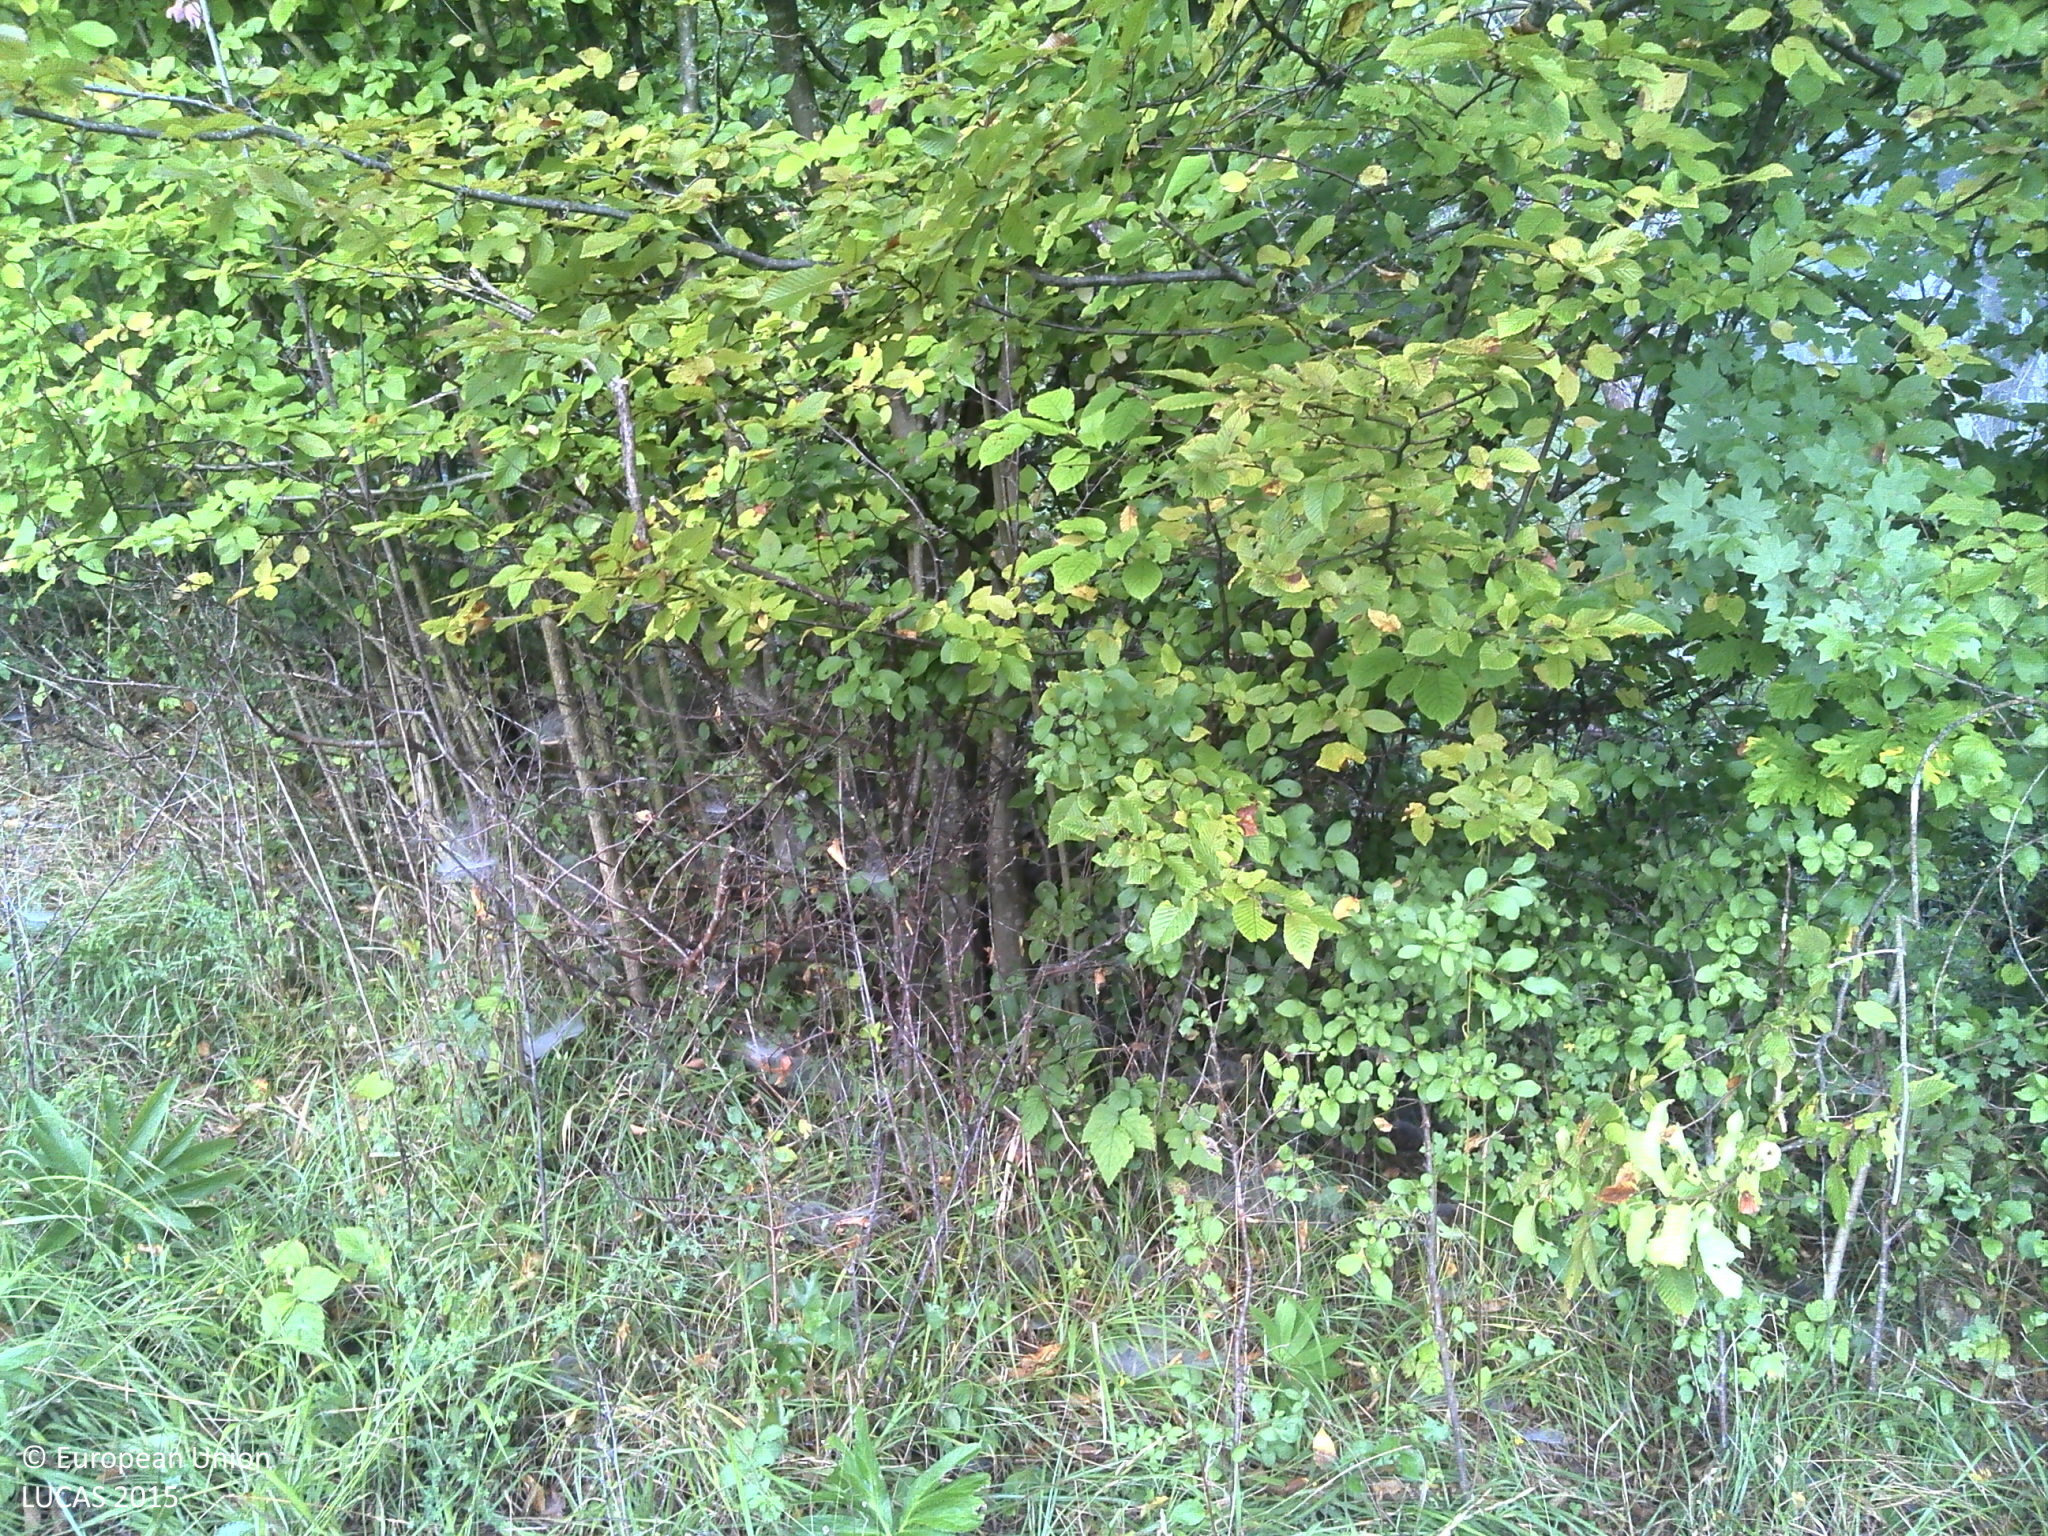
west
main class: Grassland
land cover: Spontaneously vegetated surfaces
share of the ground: > 75 %
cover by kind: herbaceous plants 95 %, shrubs 5 %
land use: Semi-natural and natural areas not in use
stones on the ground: < 10 %
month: August
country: HR
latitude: 45.1689
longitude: 16.3457
